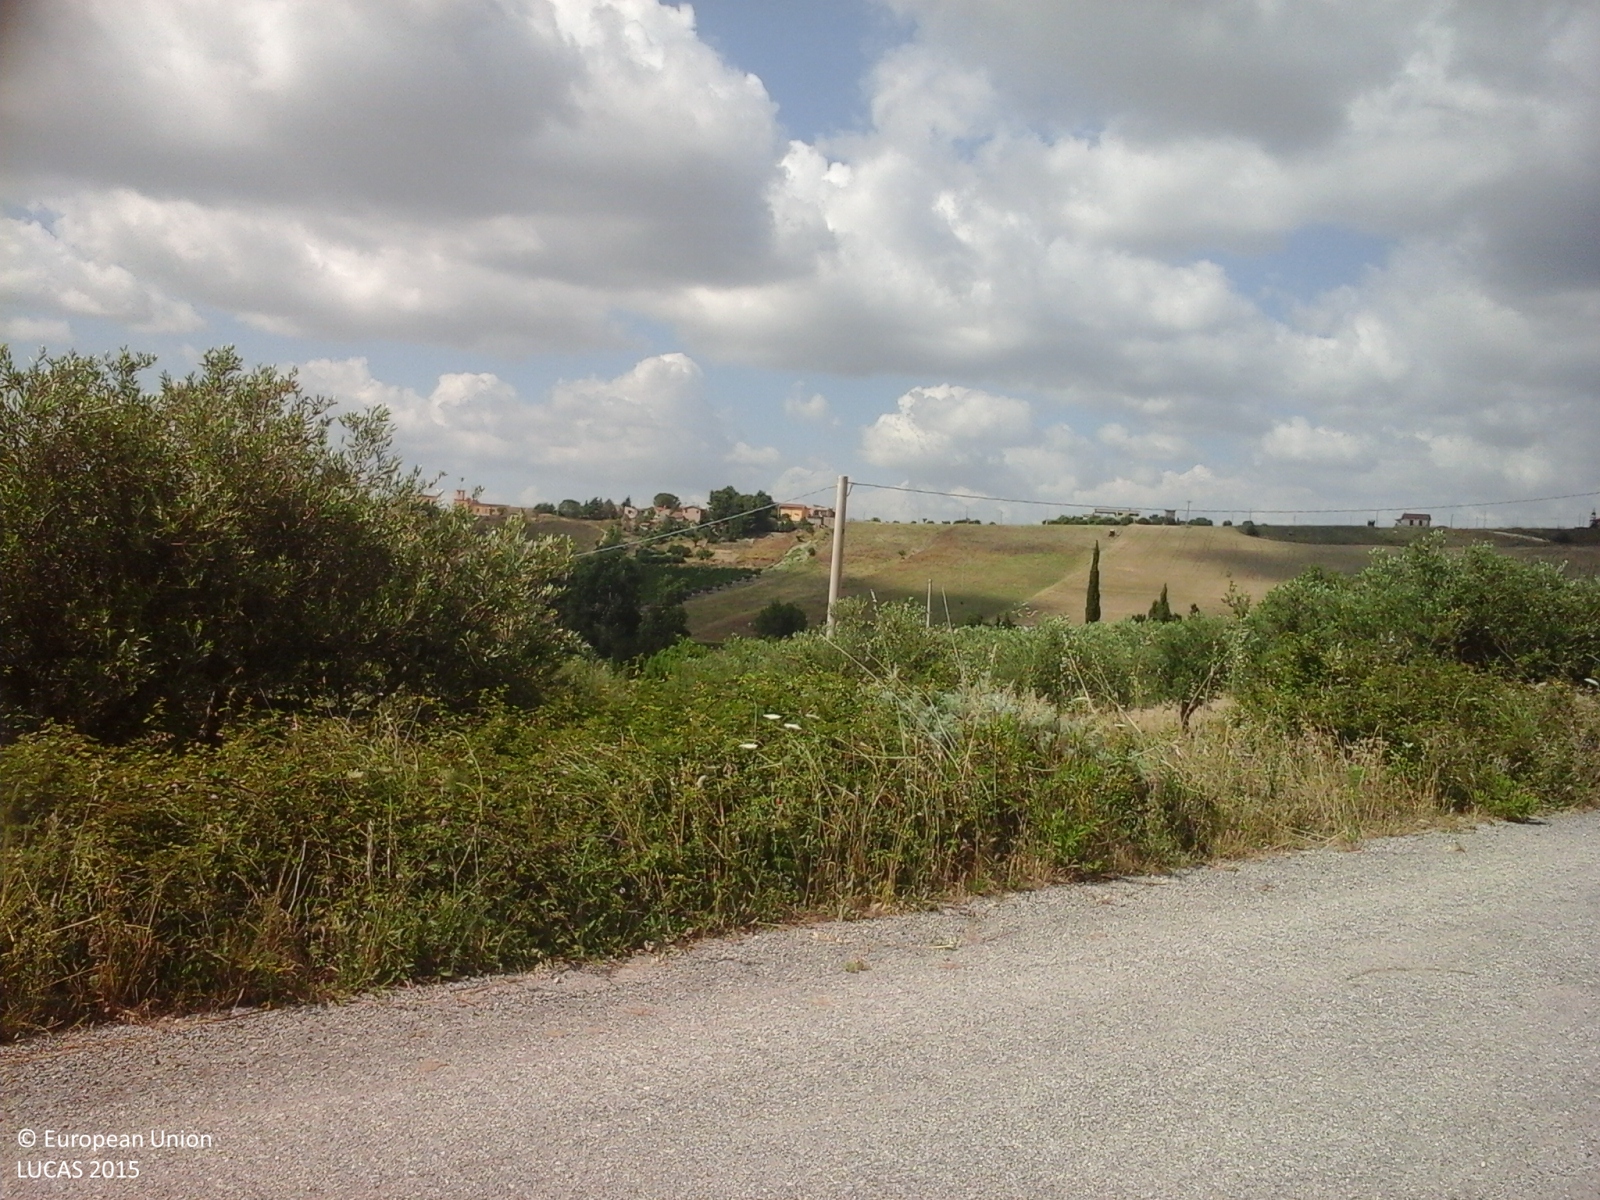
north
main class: Cropland
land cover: Durum wheat
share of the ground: > 75 %
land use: Agriculture (excluding fallow land and kitchen gardens)
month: June
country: IT
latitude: 37.7320
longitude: 13.1424
